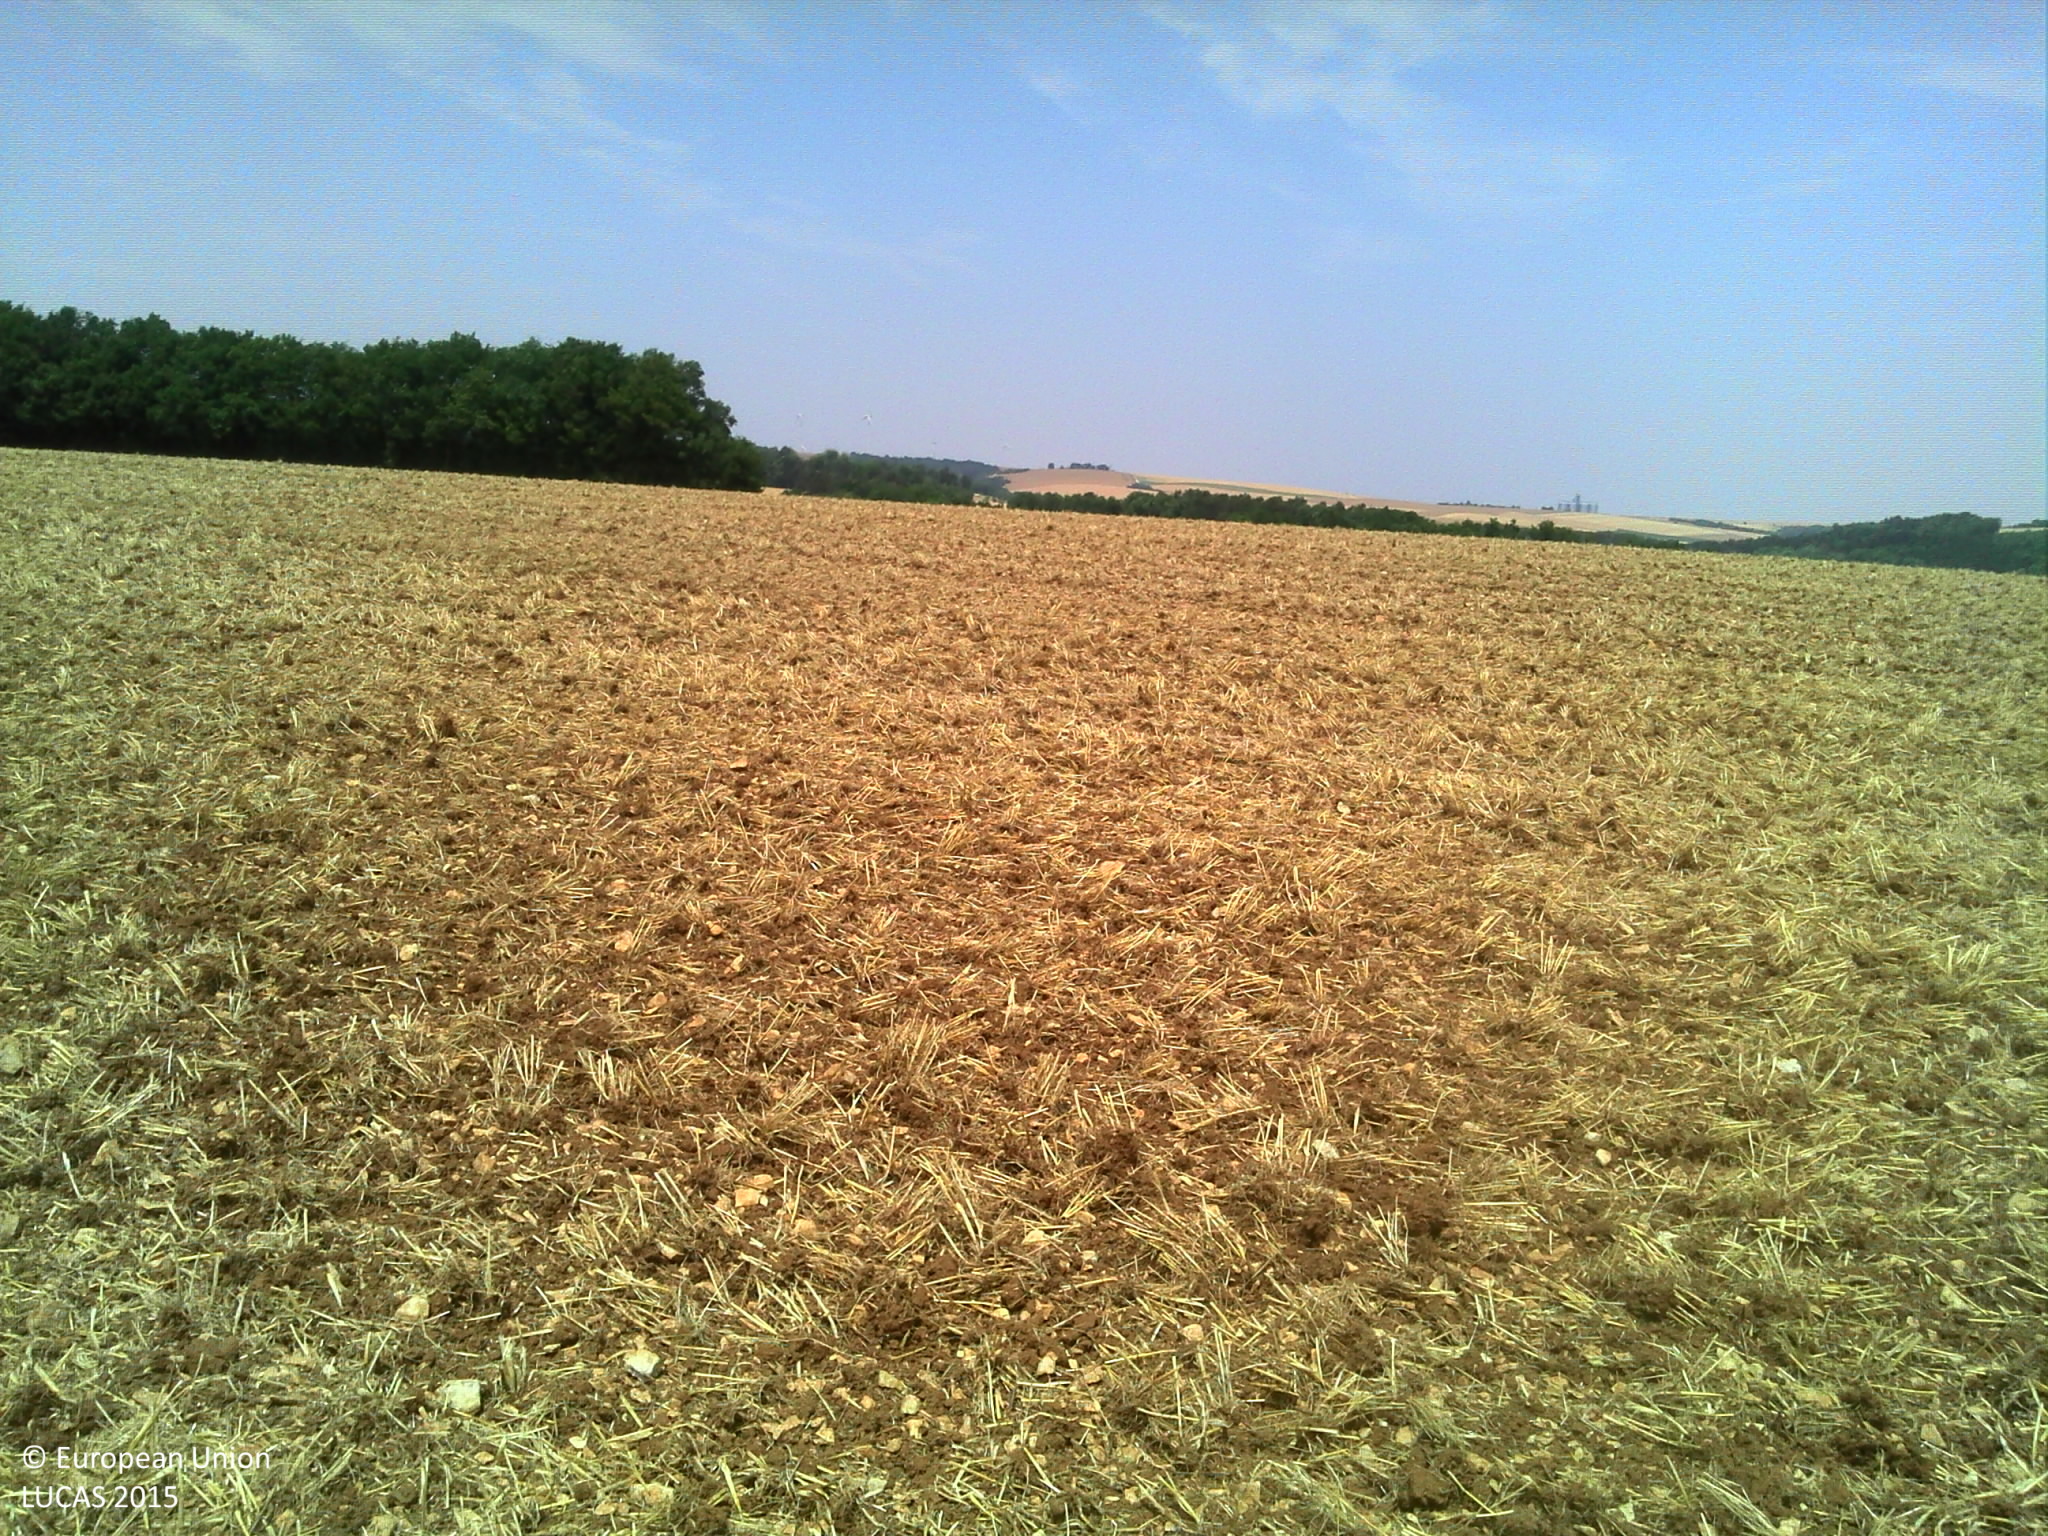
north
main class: Cropland
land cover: Barley
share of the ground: > 75 %
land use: Agriculture (excluding fallow land and kitchen gardens)
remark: Harvested field
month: July
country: FR
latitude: 47.6158
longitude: 3.4900
